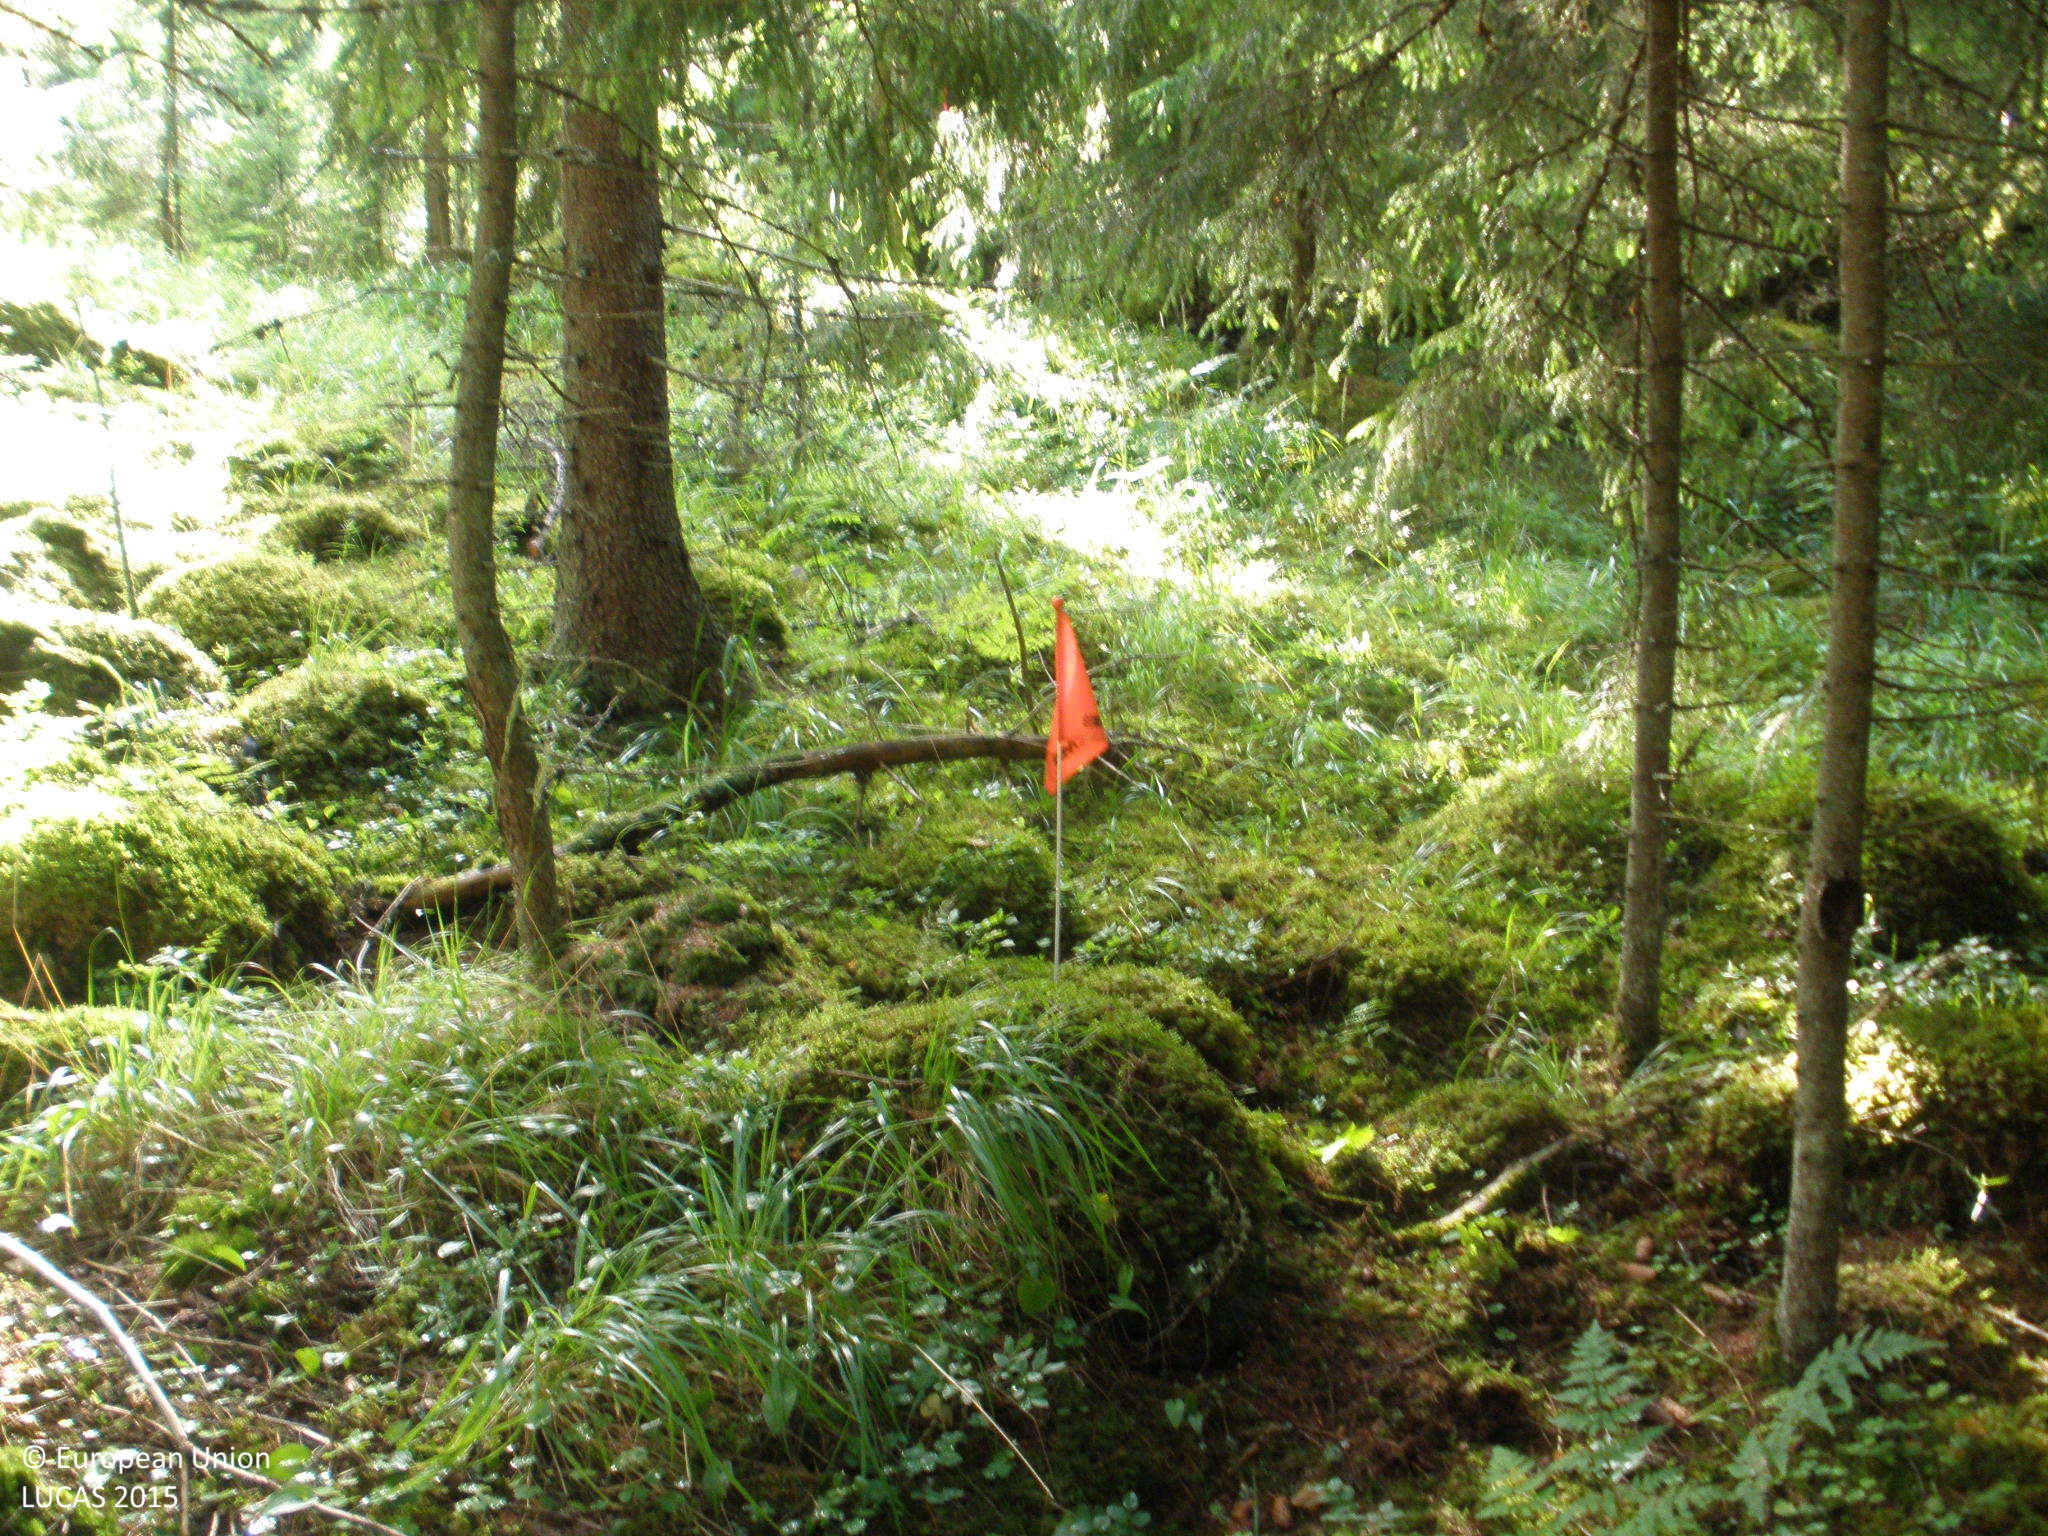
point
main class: Woodland
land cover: Spruce dominated coniferous woodland
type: boreal forest
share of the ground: > 75 %
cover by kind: coniferous forest trees 90 %, herbaceous plants 5 %, lichens and mosses 5 %
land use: Forestry
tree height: > 5 m
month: July
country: FI
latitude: 61.2558
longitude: 24.7387
